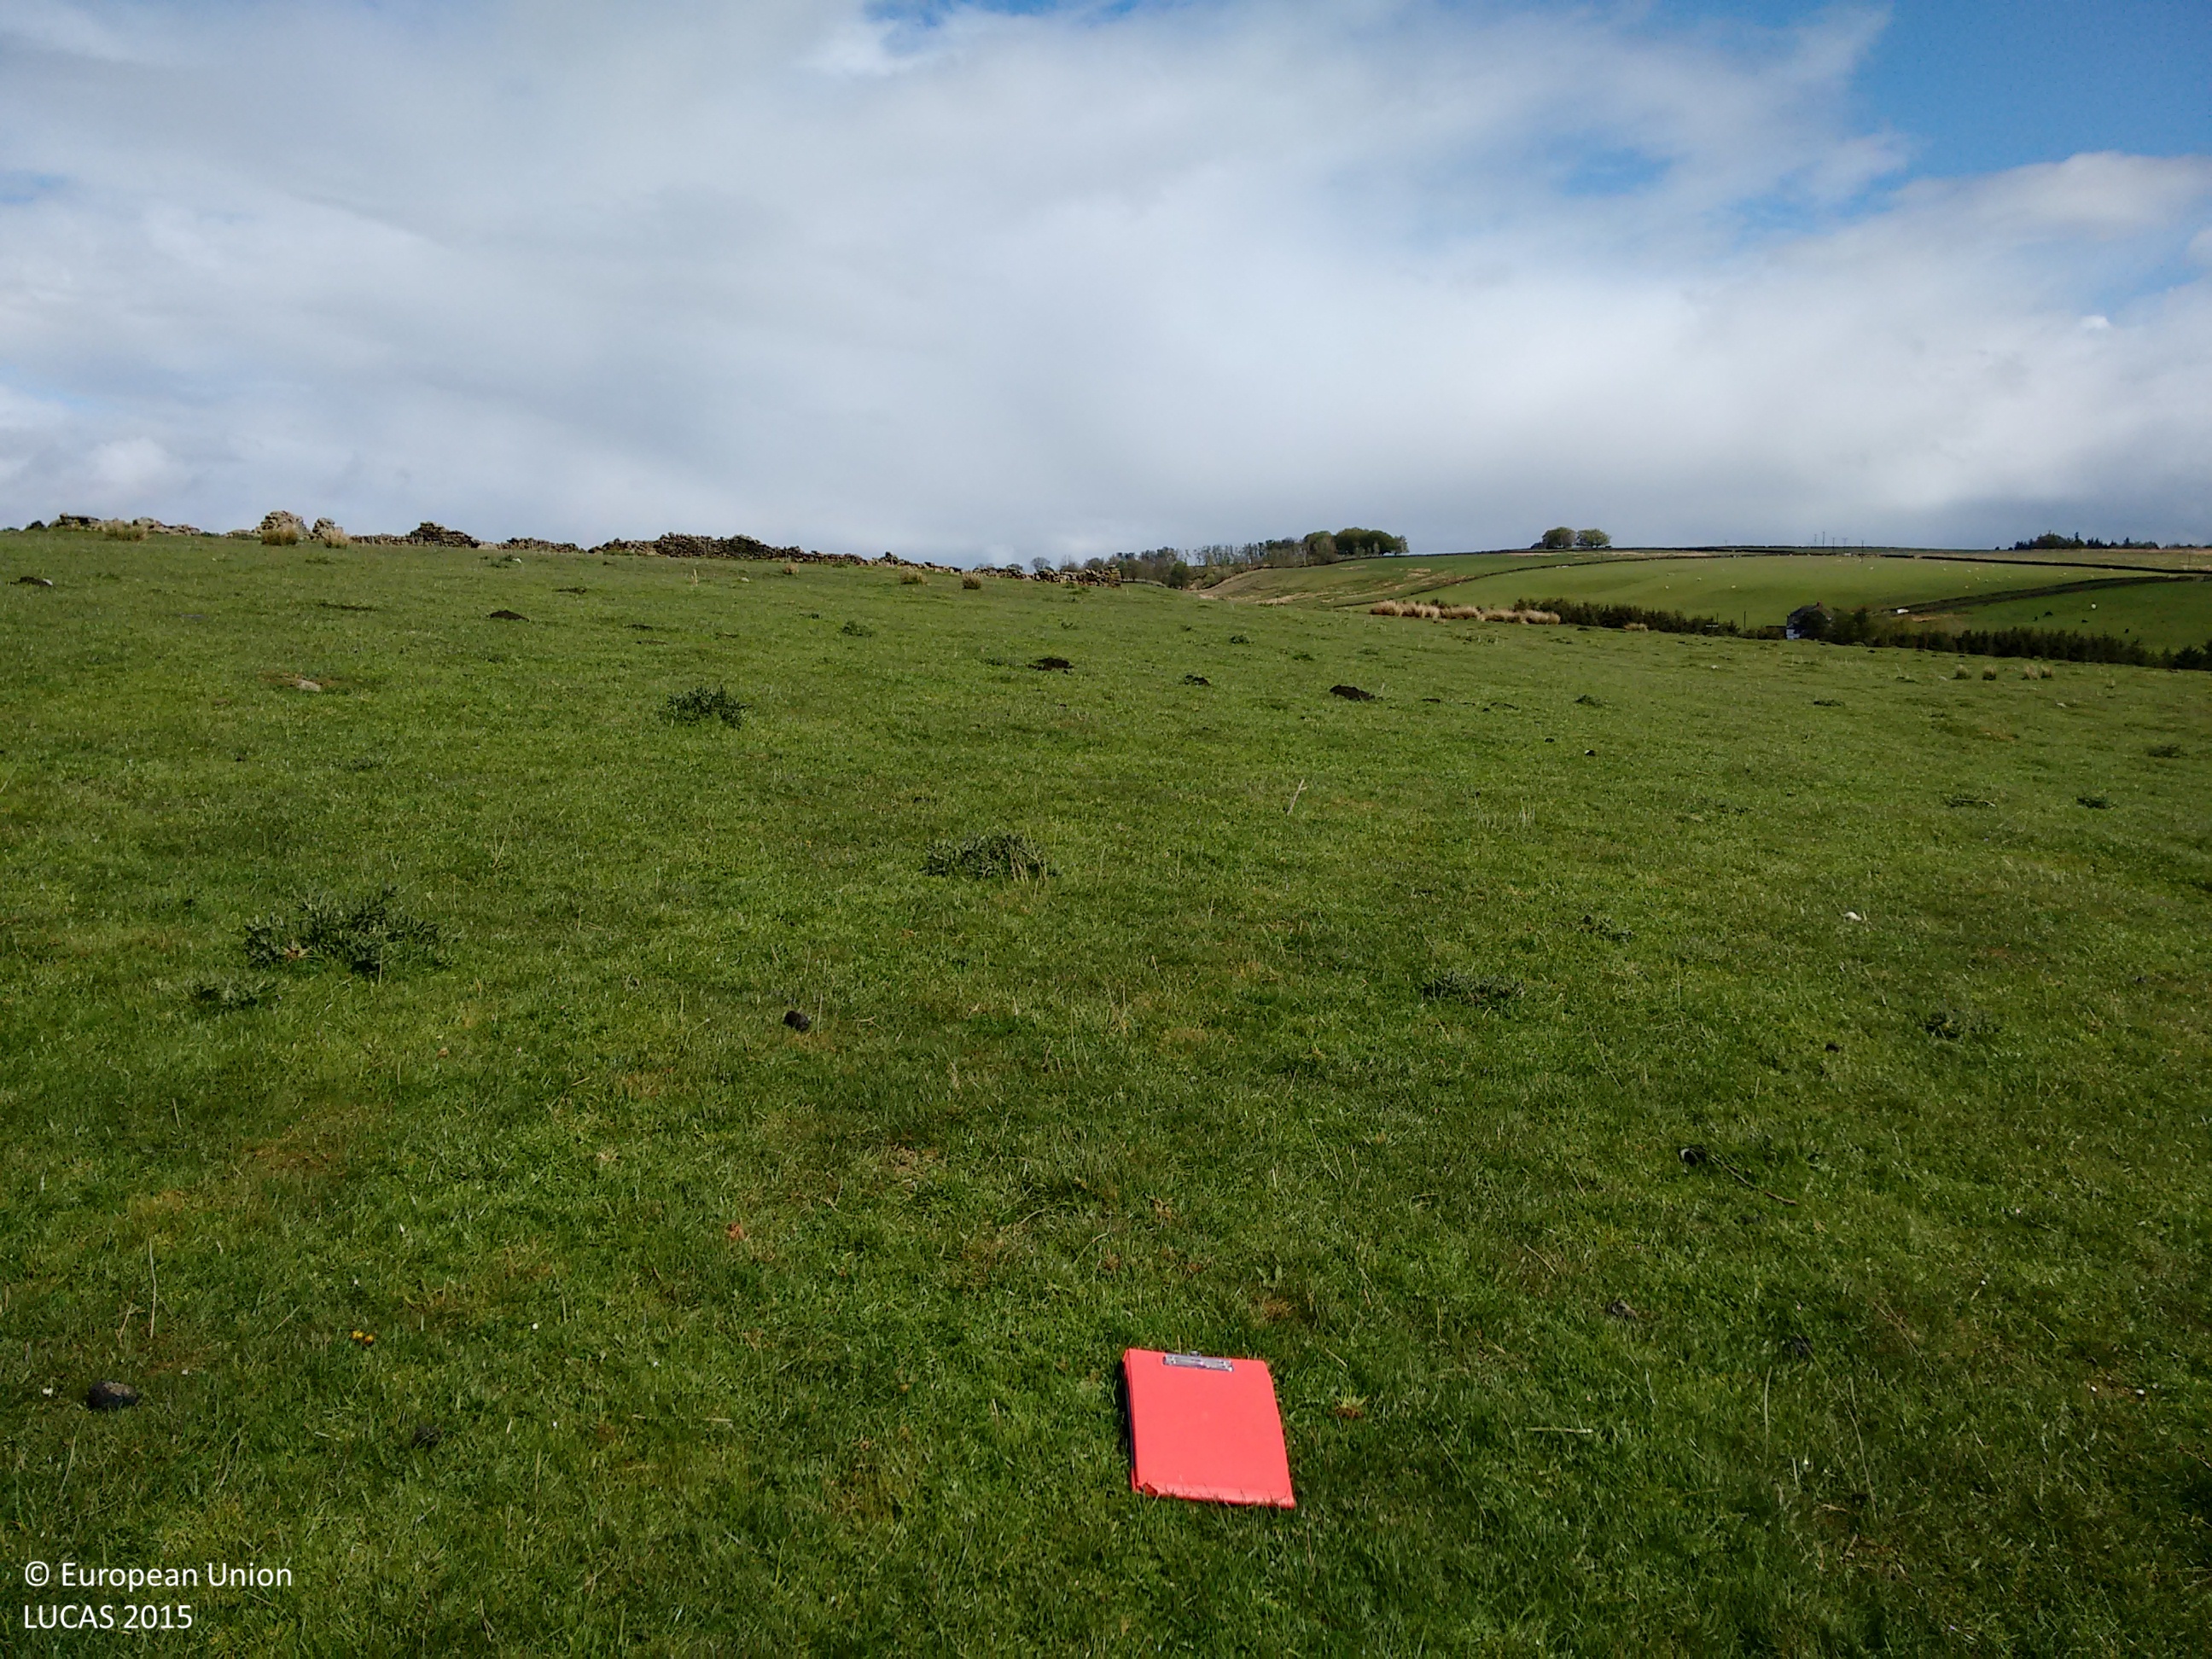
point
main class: Grassland
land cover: Grassland without tree/shrub cover
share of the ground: > 75 %
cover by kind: herbaceous plants 100 %
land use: Agriculture (excluding fallow land and kitchen gardens)
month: May
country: GB
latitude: 54.9957
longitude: -2.2668
